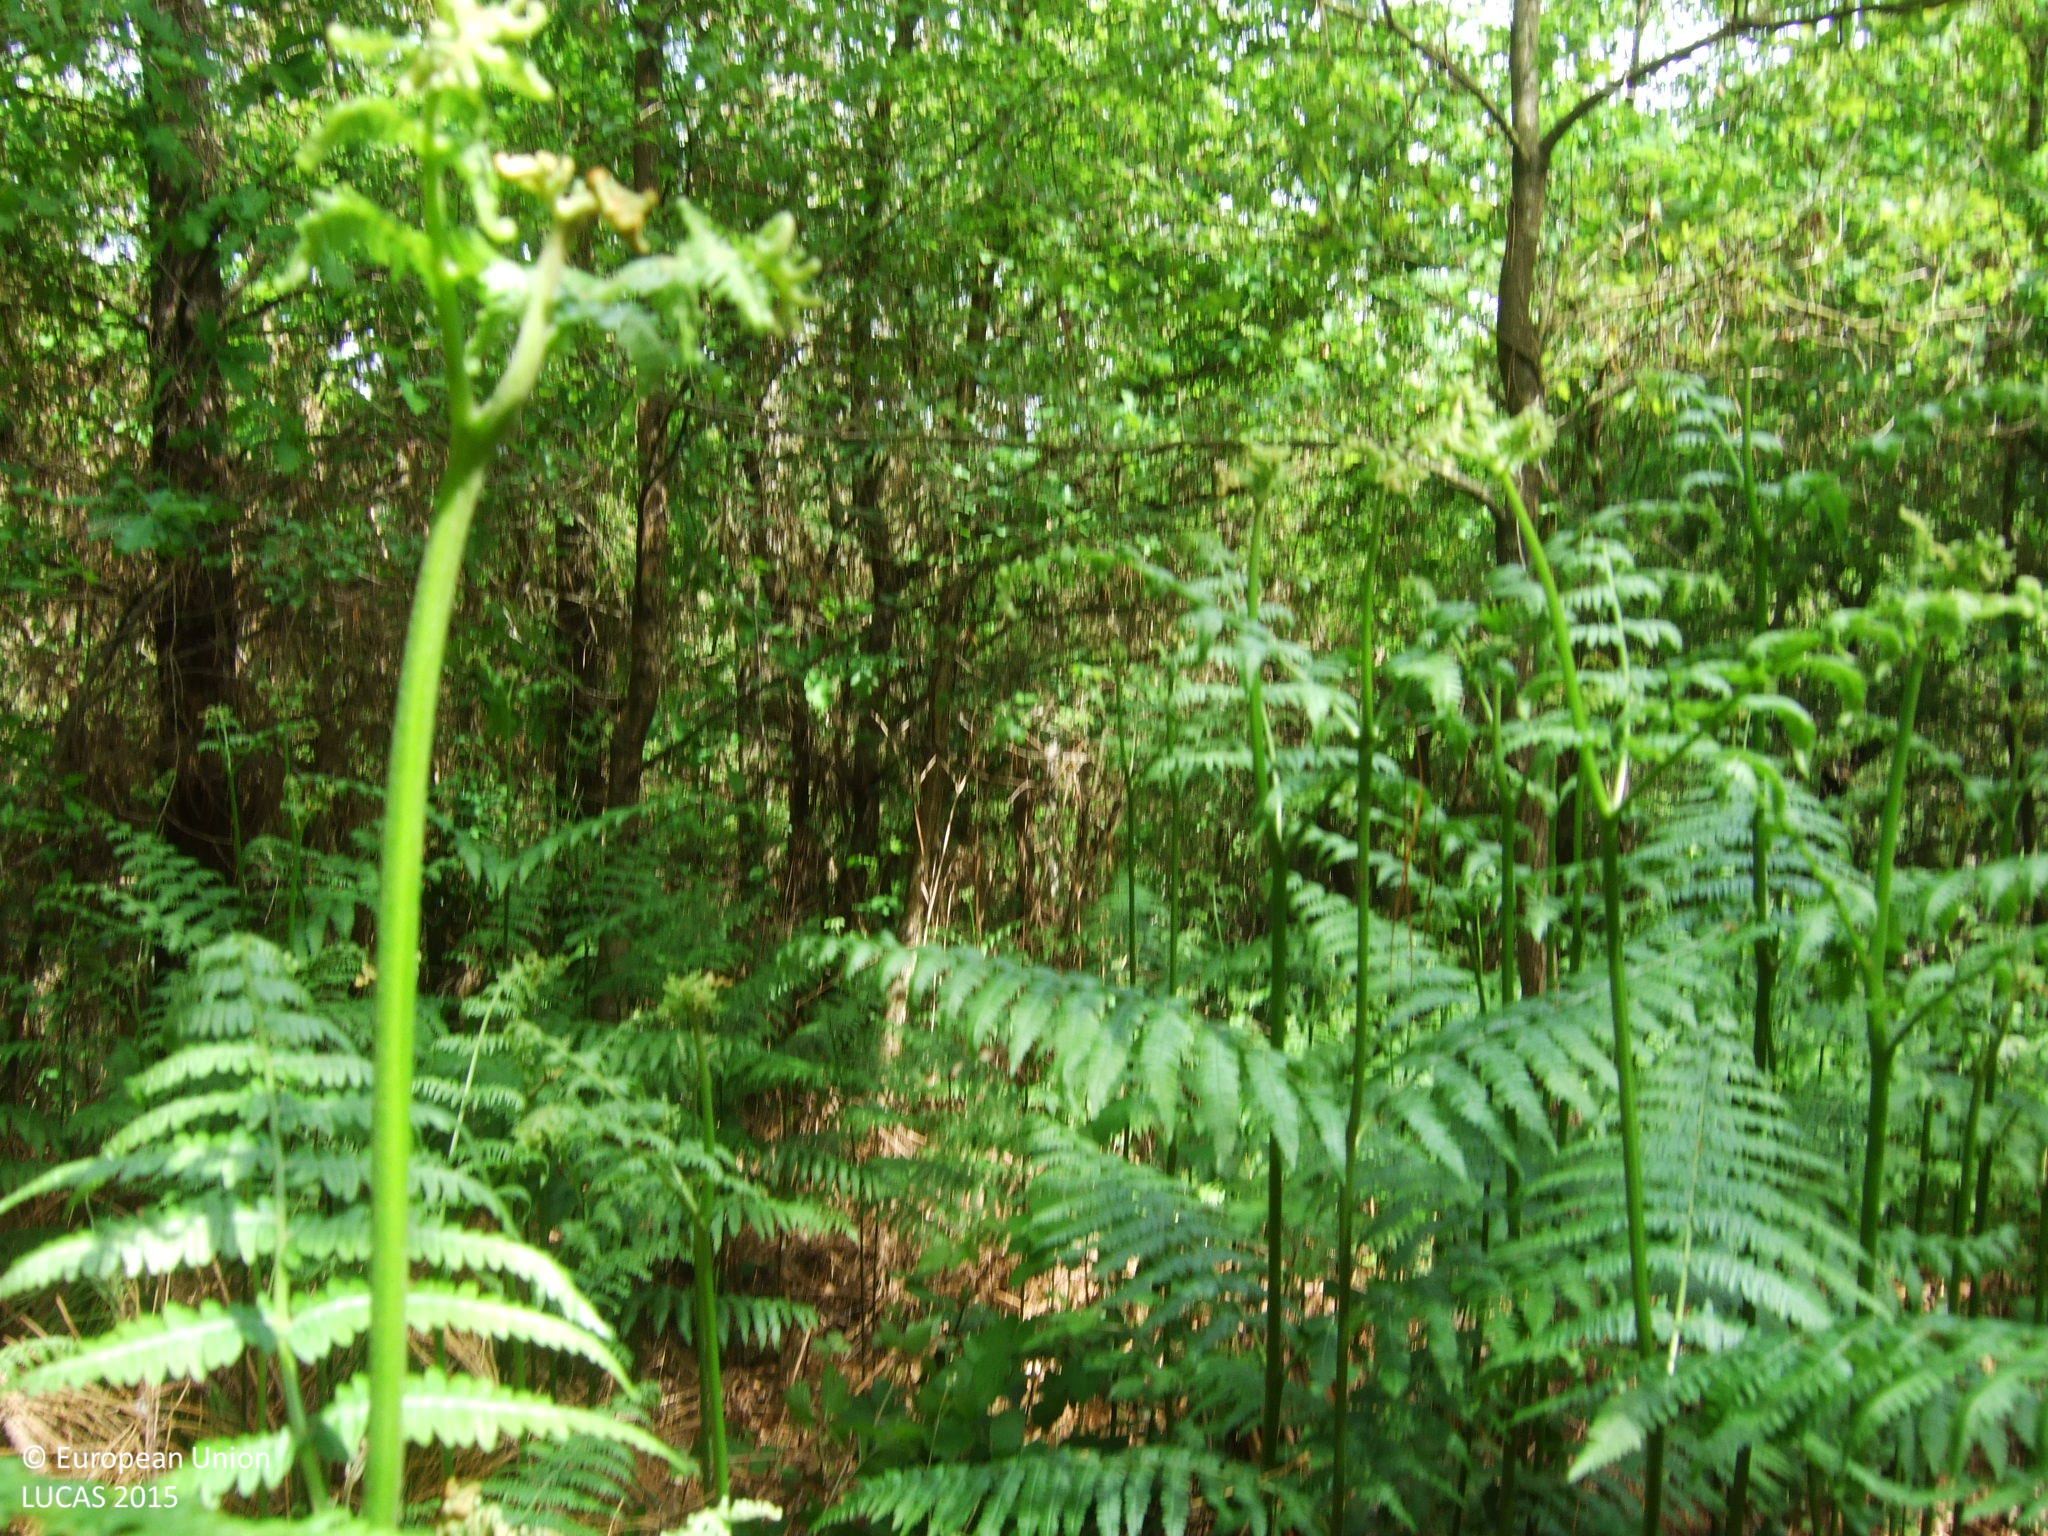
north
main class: Woodland
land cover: Broadleaved woodland
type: acidophilous oak and oak-birch forest
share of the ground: > 75 %
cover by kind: broadleaved forest trees 90 %, shrubs 10 %
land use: Forestry
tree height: > 5 m
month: May
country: ES
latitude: 42.9073
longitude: -7.3779
